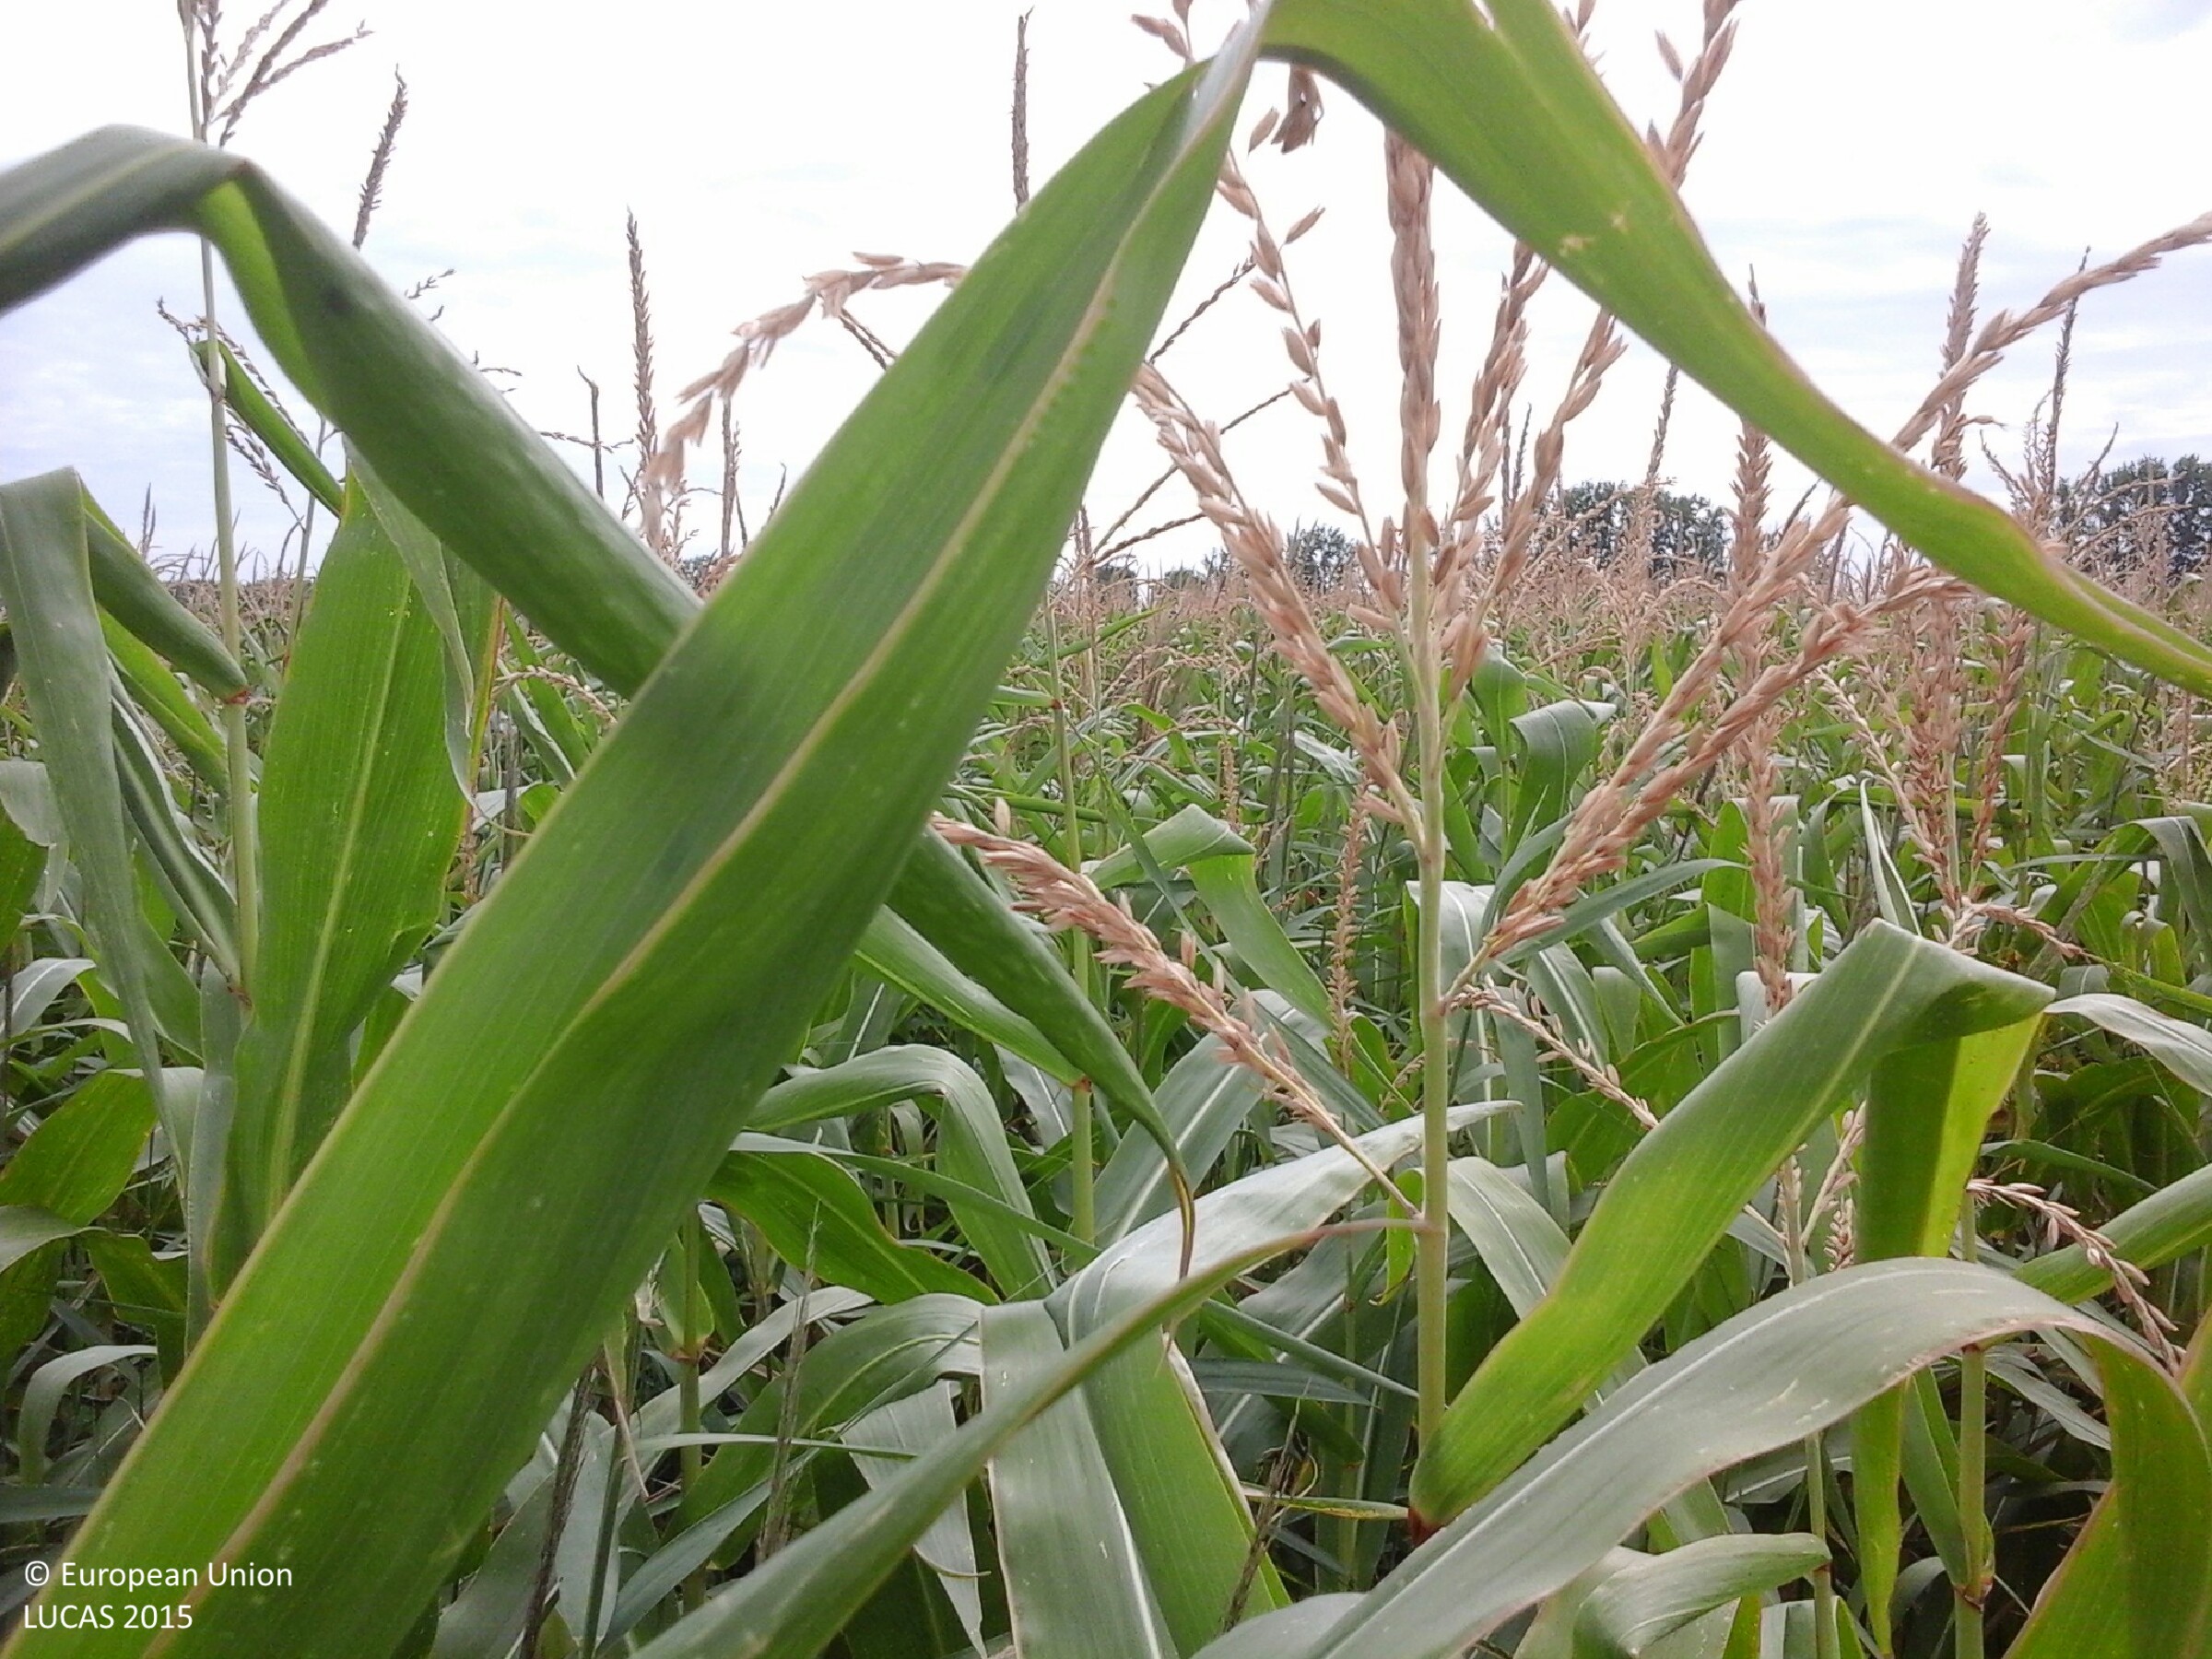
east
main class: Cropland
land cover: Maize
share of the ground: > 75 %
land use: Agriculture (excluding fallow land and kitchen gardens)
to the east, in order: Maize; Rape and turnip rape
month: July
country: HU
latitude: 47.4055
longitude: 20.7538
